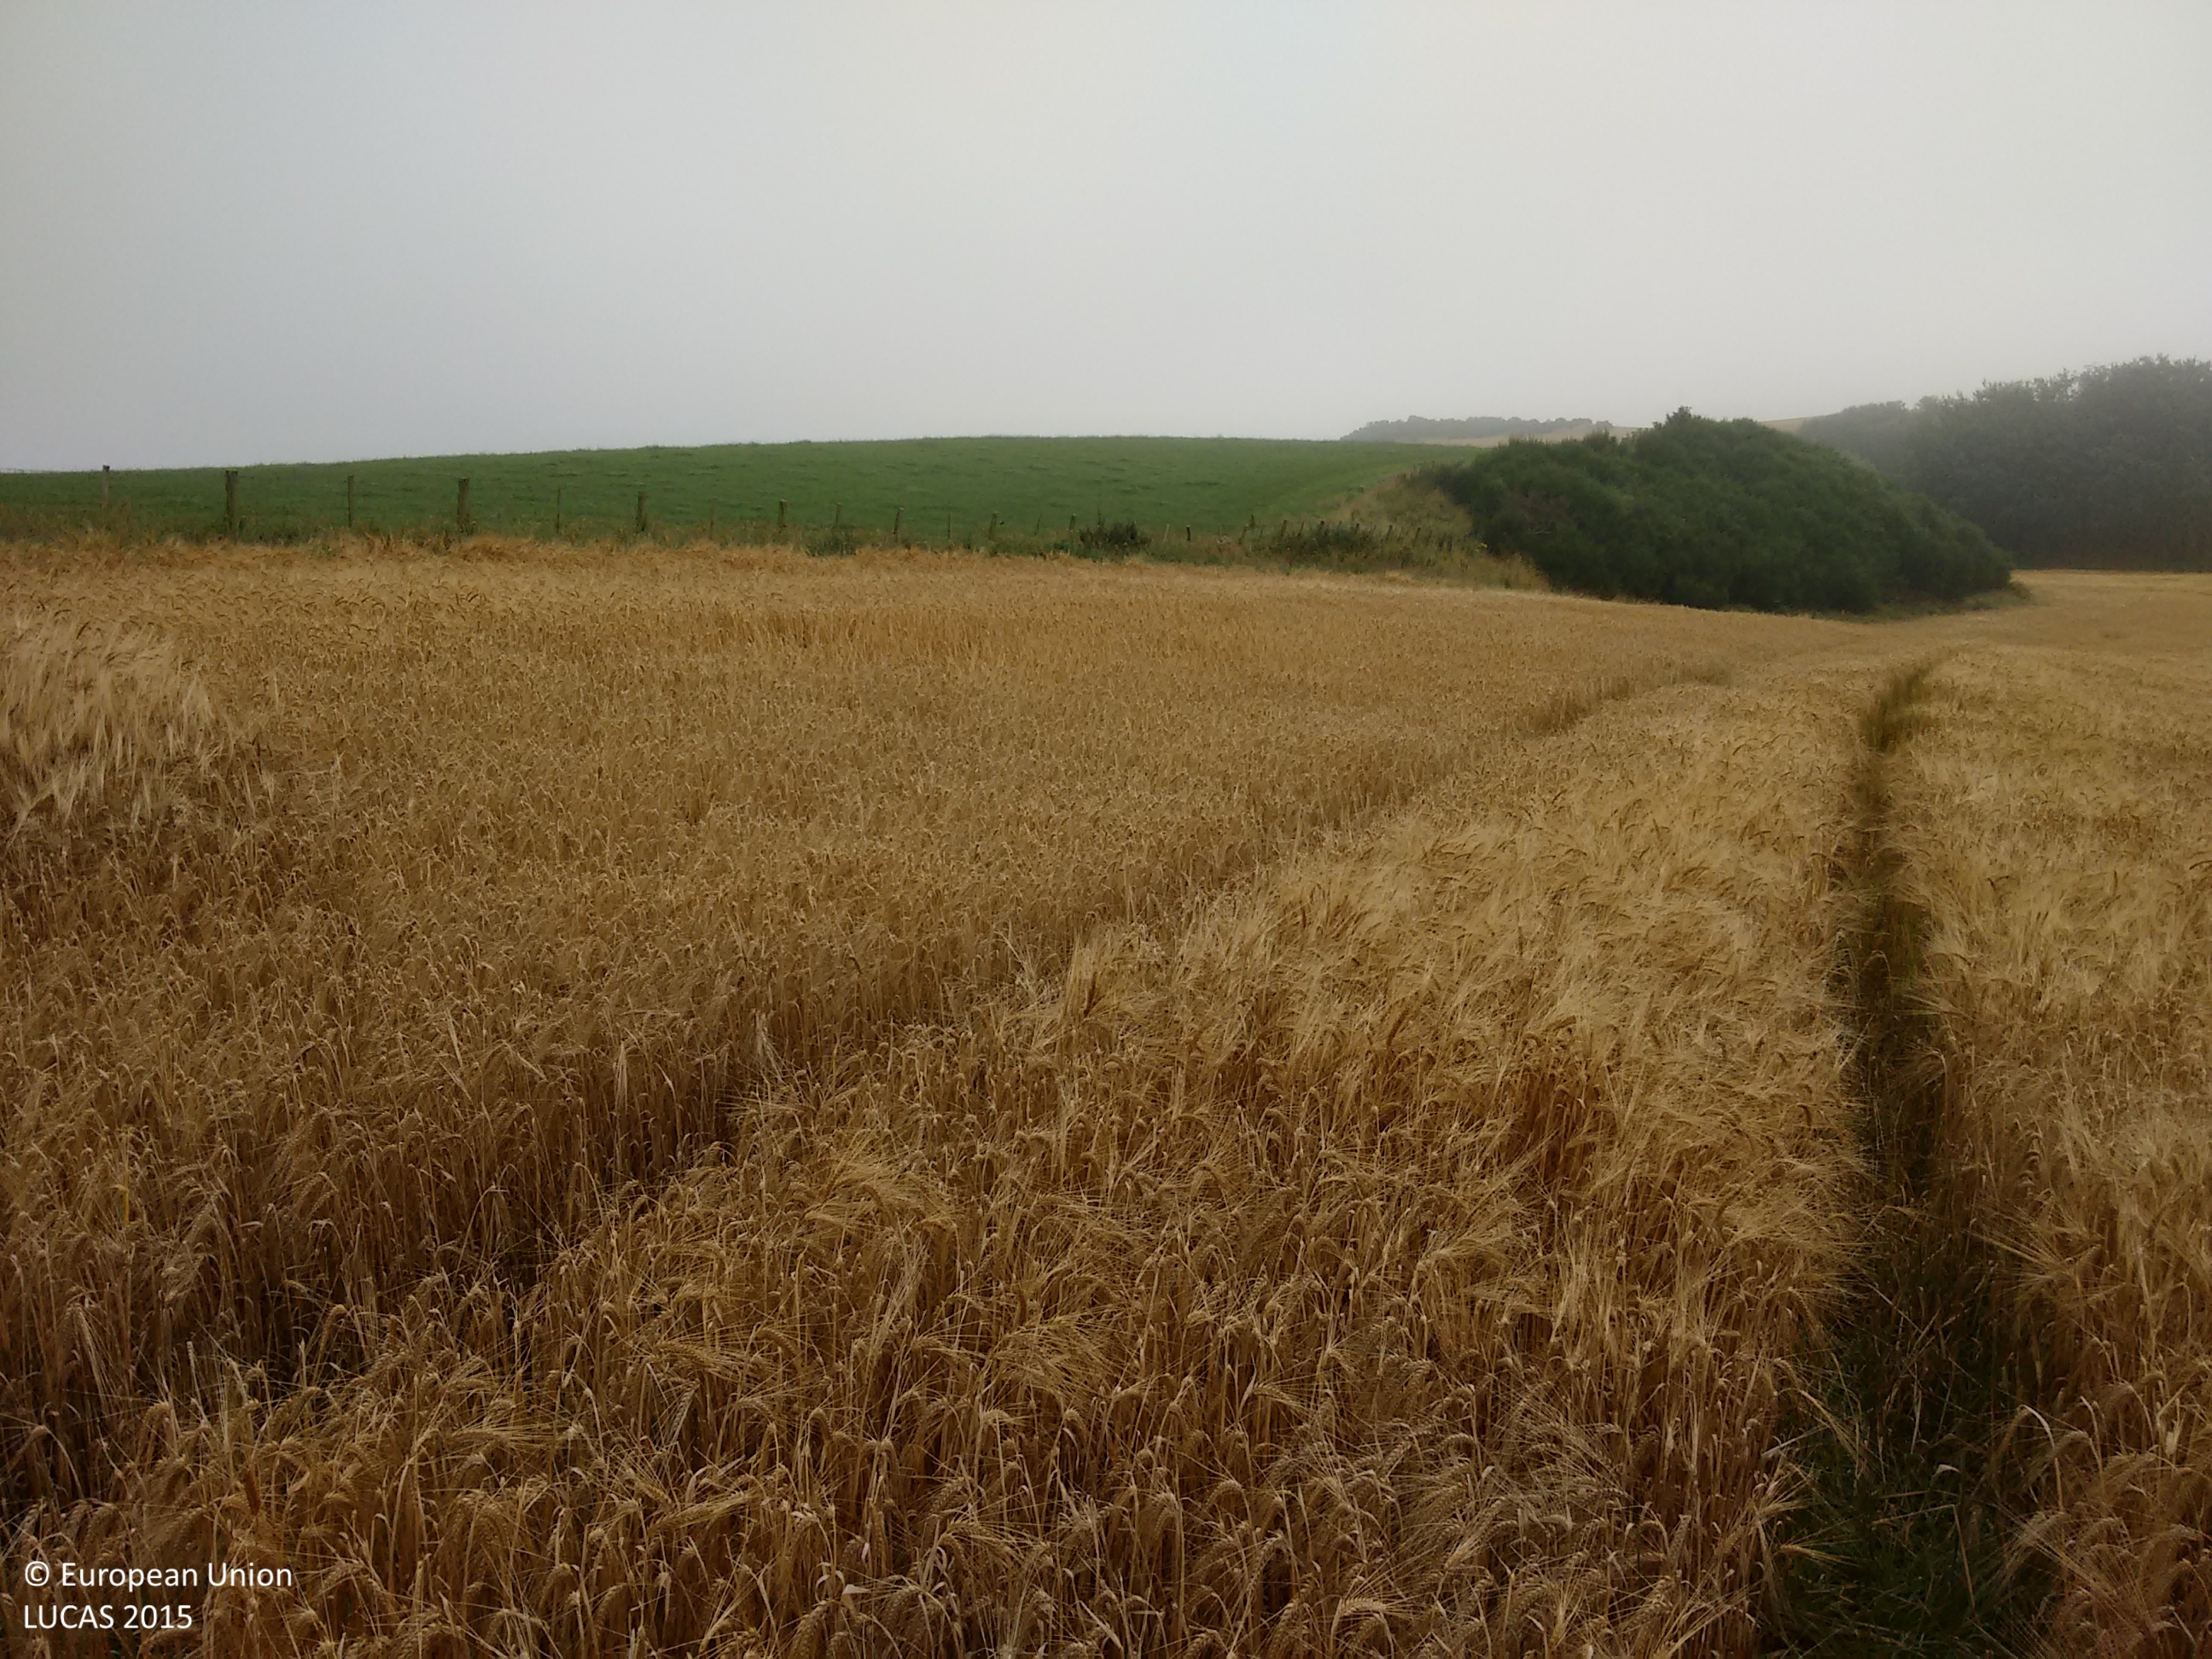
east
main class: Cropland
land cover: Barley
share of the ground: > 75 %
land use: Agriculture (excluding fallow land and kitchen gardens)
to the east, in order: Barley; Broadleaved woodland; Fences; Broadleaved woodland; Inland fresh running water; Broadleaved woodland; Barley
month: September
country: GB
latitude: 57.5193
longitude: -3.8173
